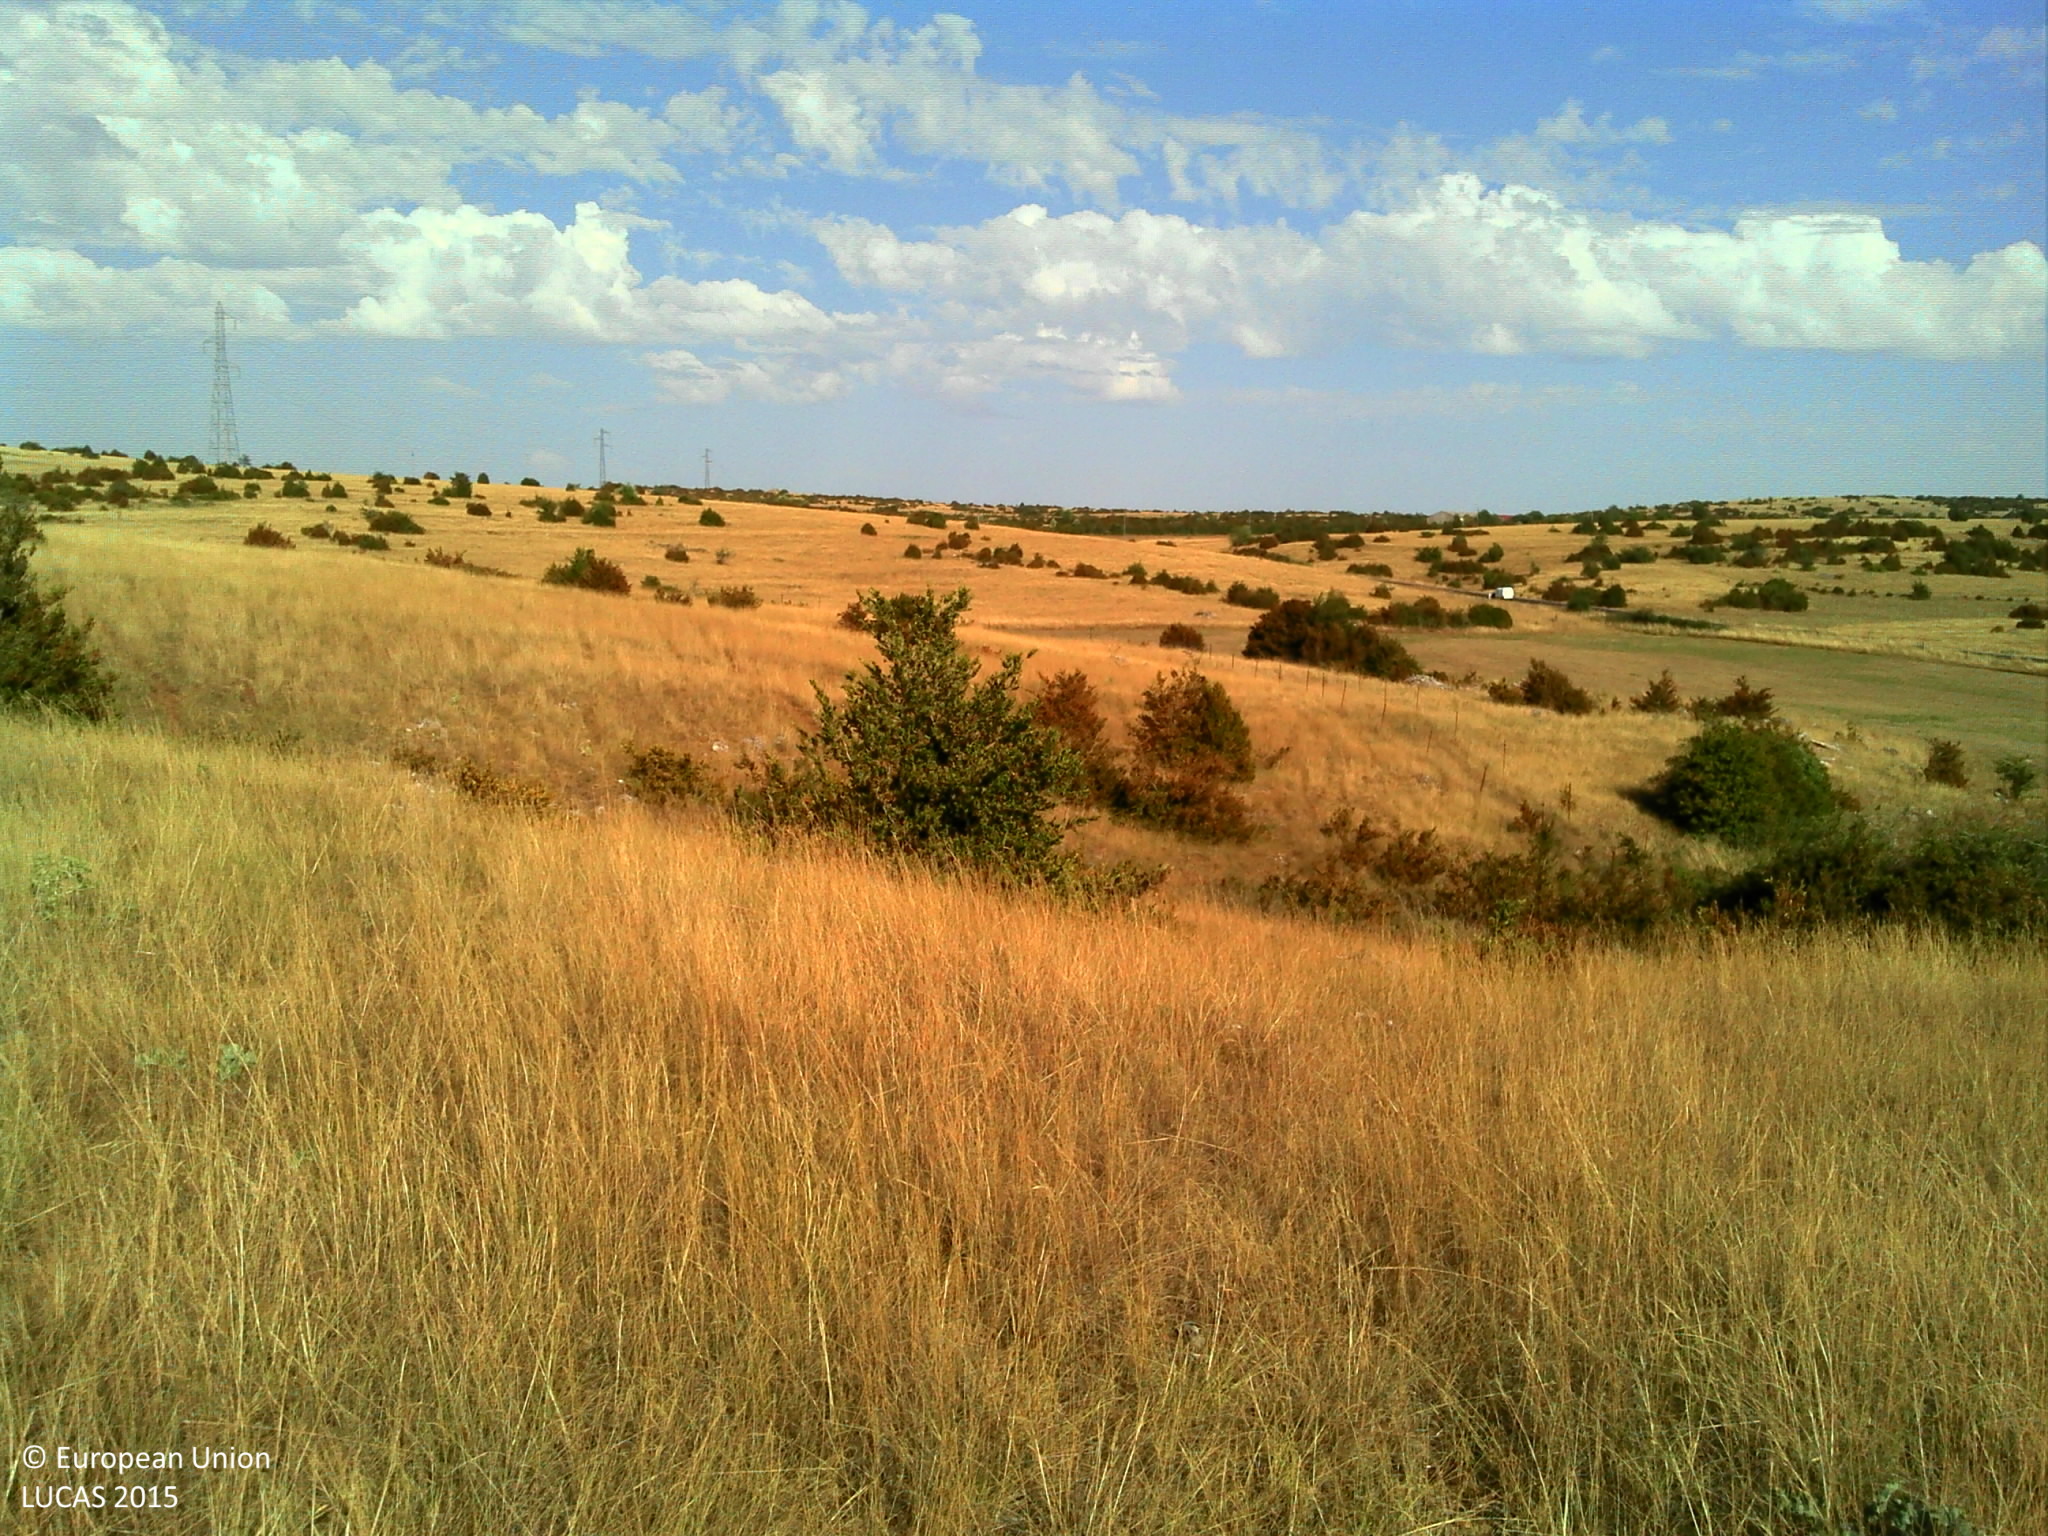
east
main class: Grassland
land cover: Grassland without tree/shrub cover
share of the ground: > 75 %
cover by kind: herbaceous plants 95 %, shrubs 5 %
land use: Agriculture (excluding fallow land and kitchen gardens)
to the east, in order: Grassland without tree/shrub cover; Grassland with sparse tree/shrub cover; Shrubland without tree cover; Fences; Shrubland without tree cover; Fences; Abandoned hedges; Lucerne; Fences; Shrubland without tree cover; Grassland with sparse tree/shrub cover
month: August
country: FR
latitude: 43.9589
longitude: 3.1149
